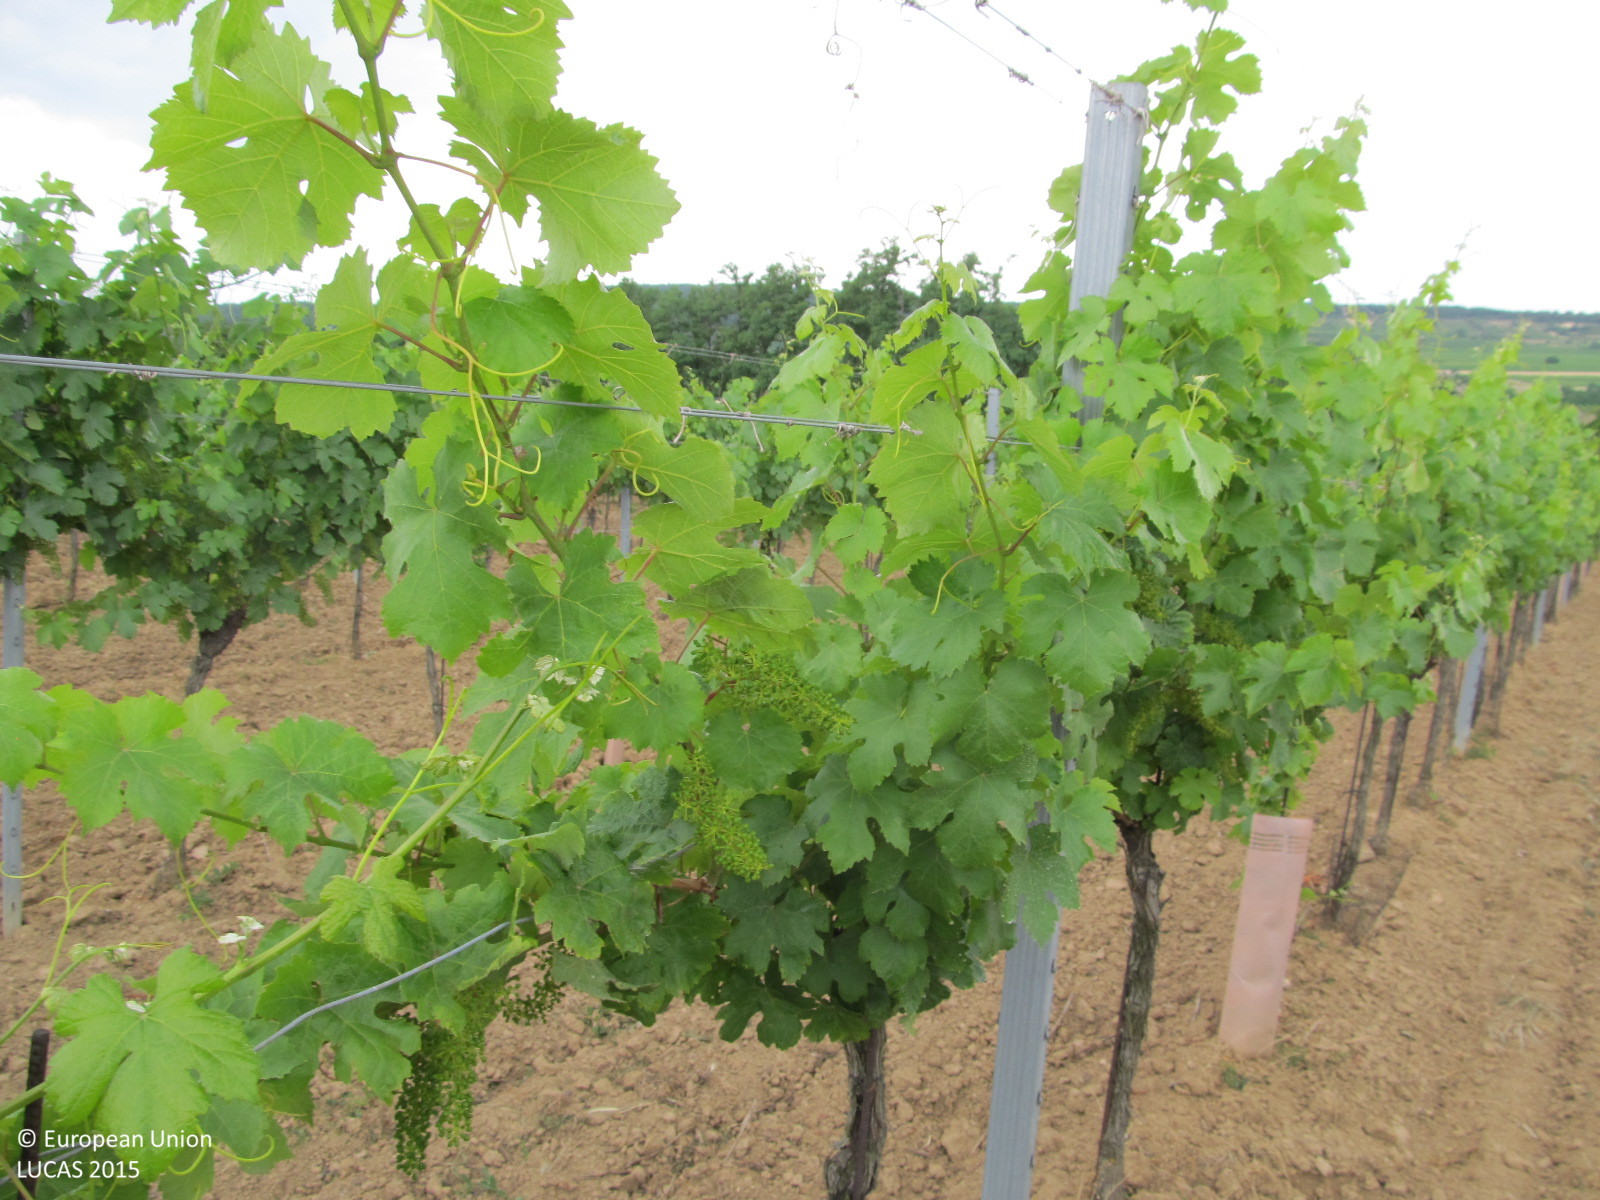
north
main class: Cropland
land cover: Vineyards
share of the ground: 25 - 50 %
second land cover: Other bare soil
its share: > 75 %
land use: Agriculture (excluding fallow land and kitchen gardens)
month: June
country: AT
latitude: 48.7500
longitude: 15.9207
